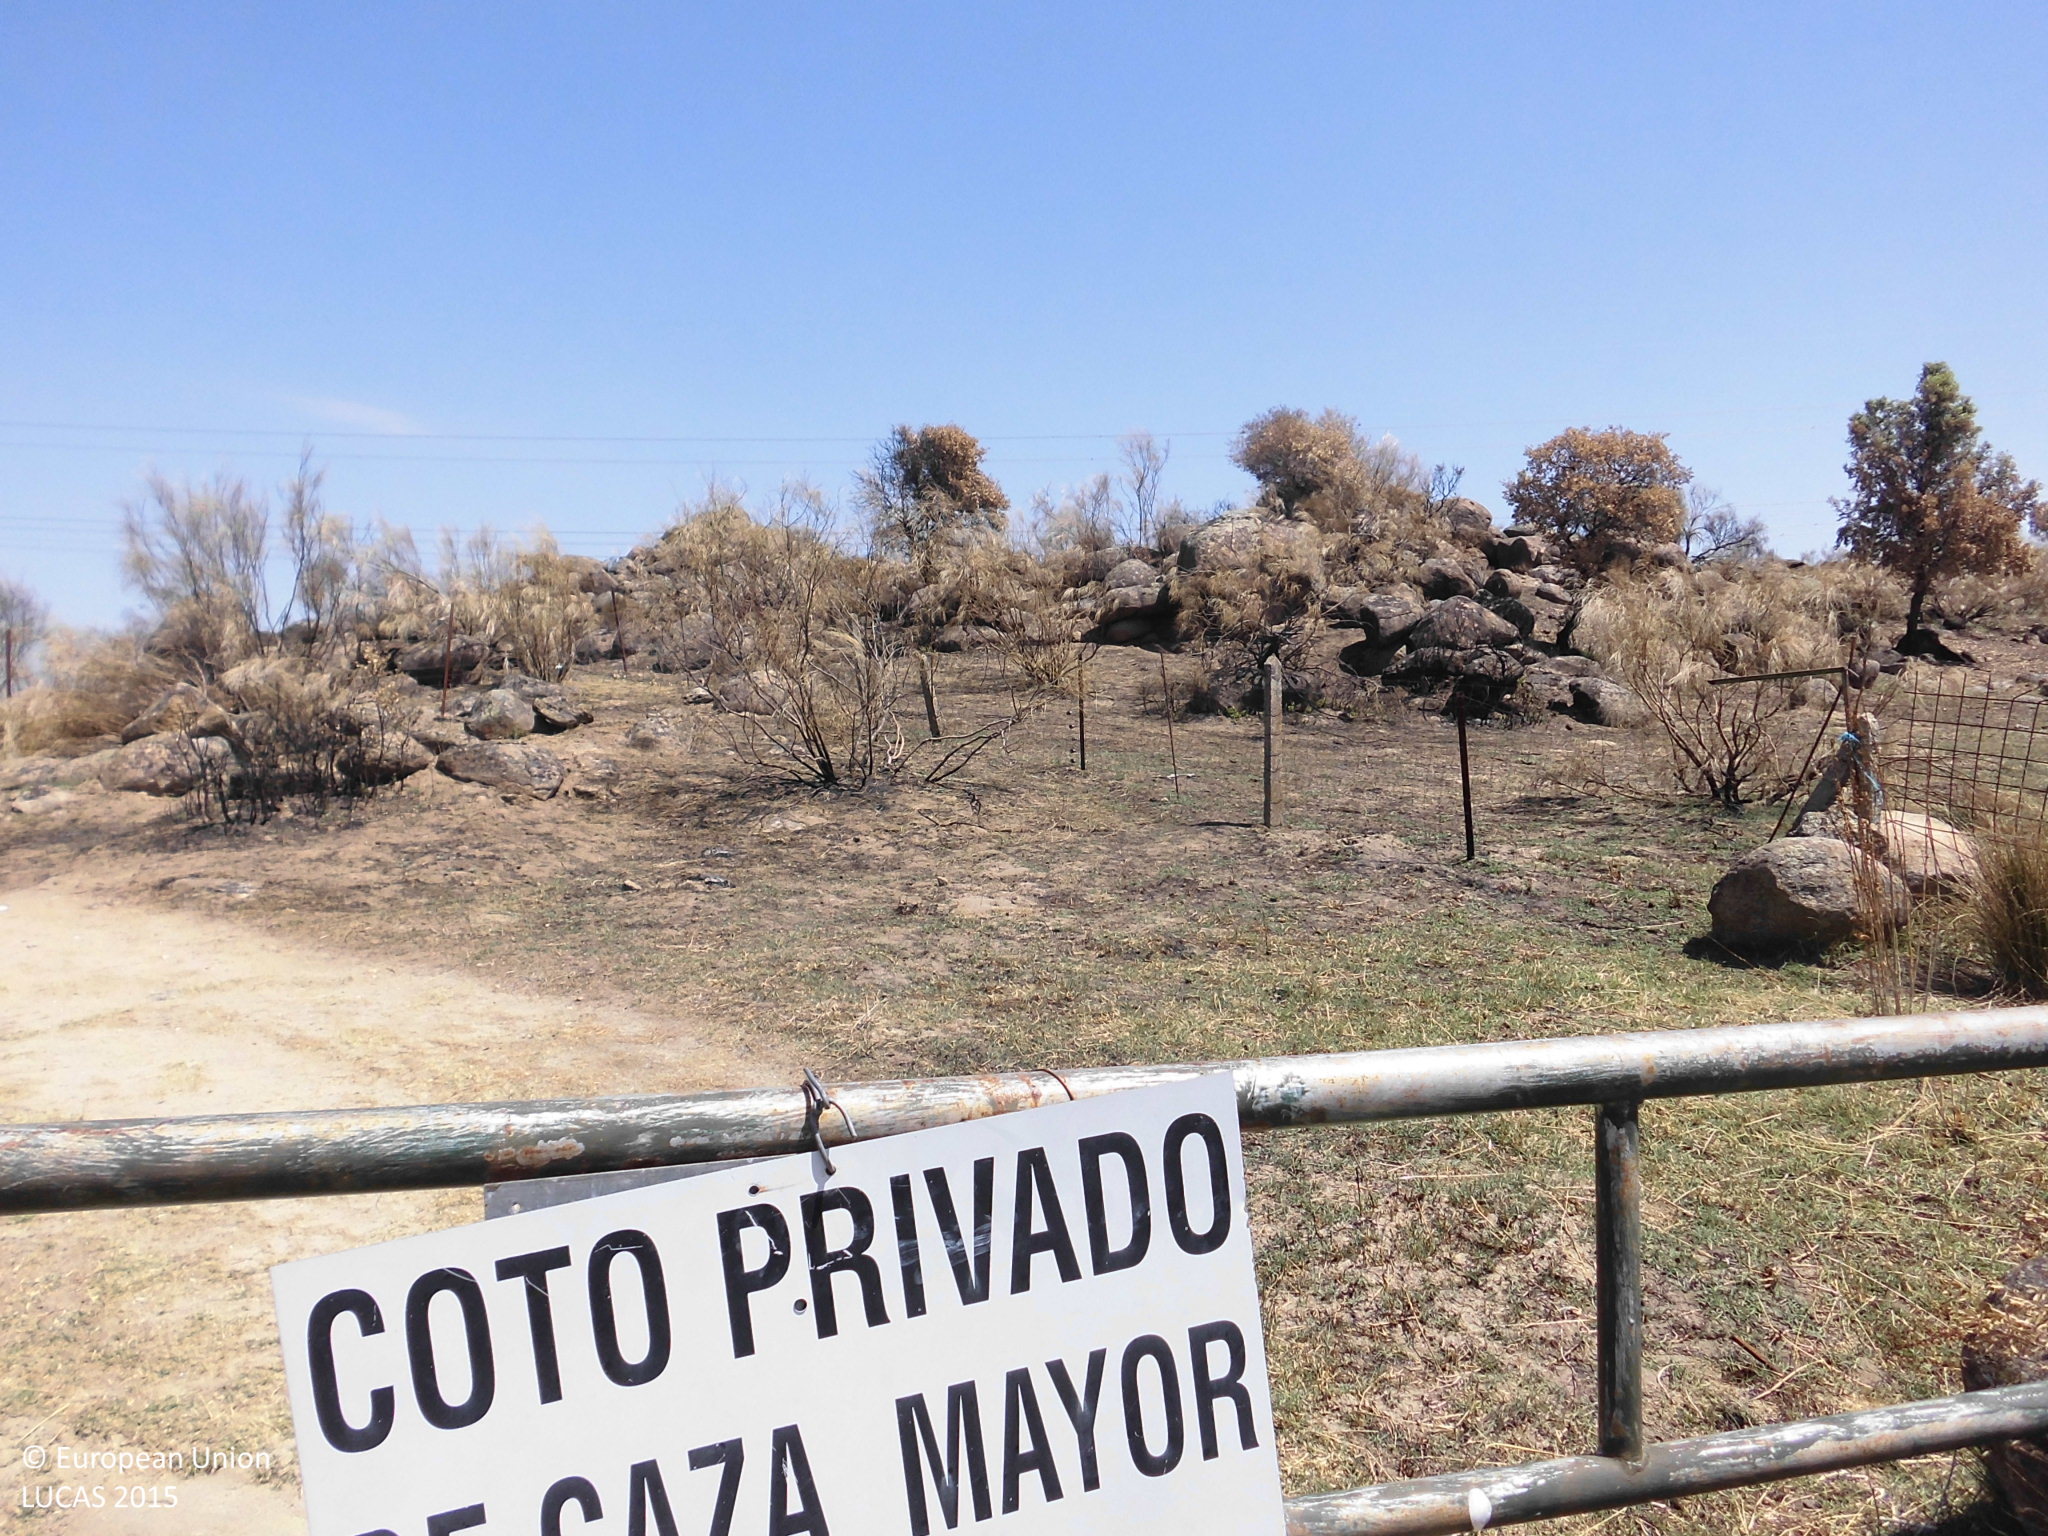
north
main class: Woodland
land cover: Broadleaved woodland
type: broadleaved evergreen forest
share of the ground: 10 - 25 %
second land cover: Grassland without tree/shrub cover
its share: > 75 %
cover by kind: herbaceous plants 80 %, broadleaved forest trees 10 %, shrubs 10 %
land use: Forestry
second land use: Agriculture (excluding fallow land and kitchen gardens)
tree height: > 5 m
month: July
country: ES
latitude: 39.7772
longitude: -5.4079
